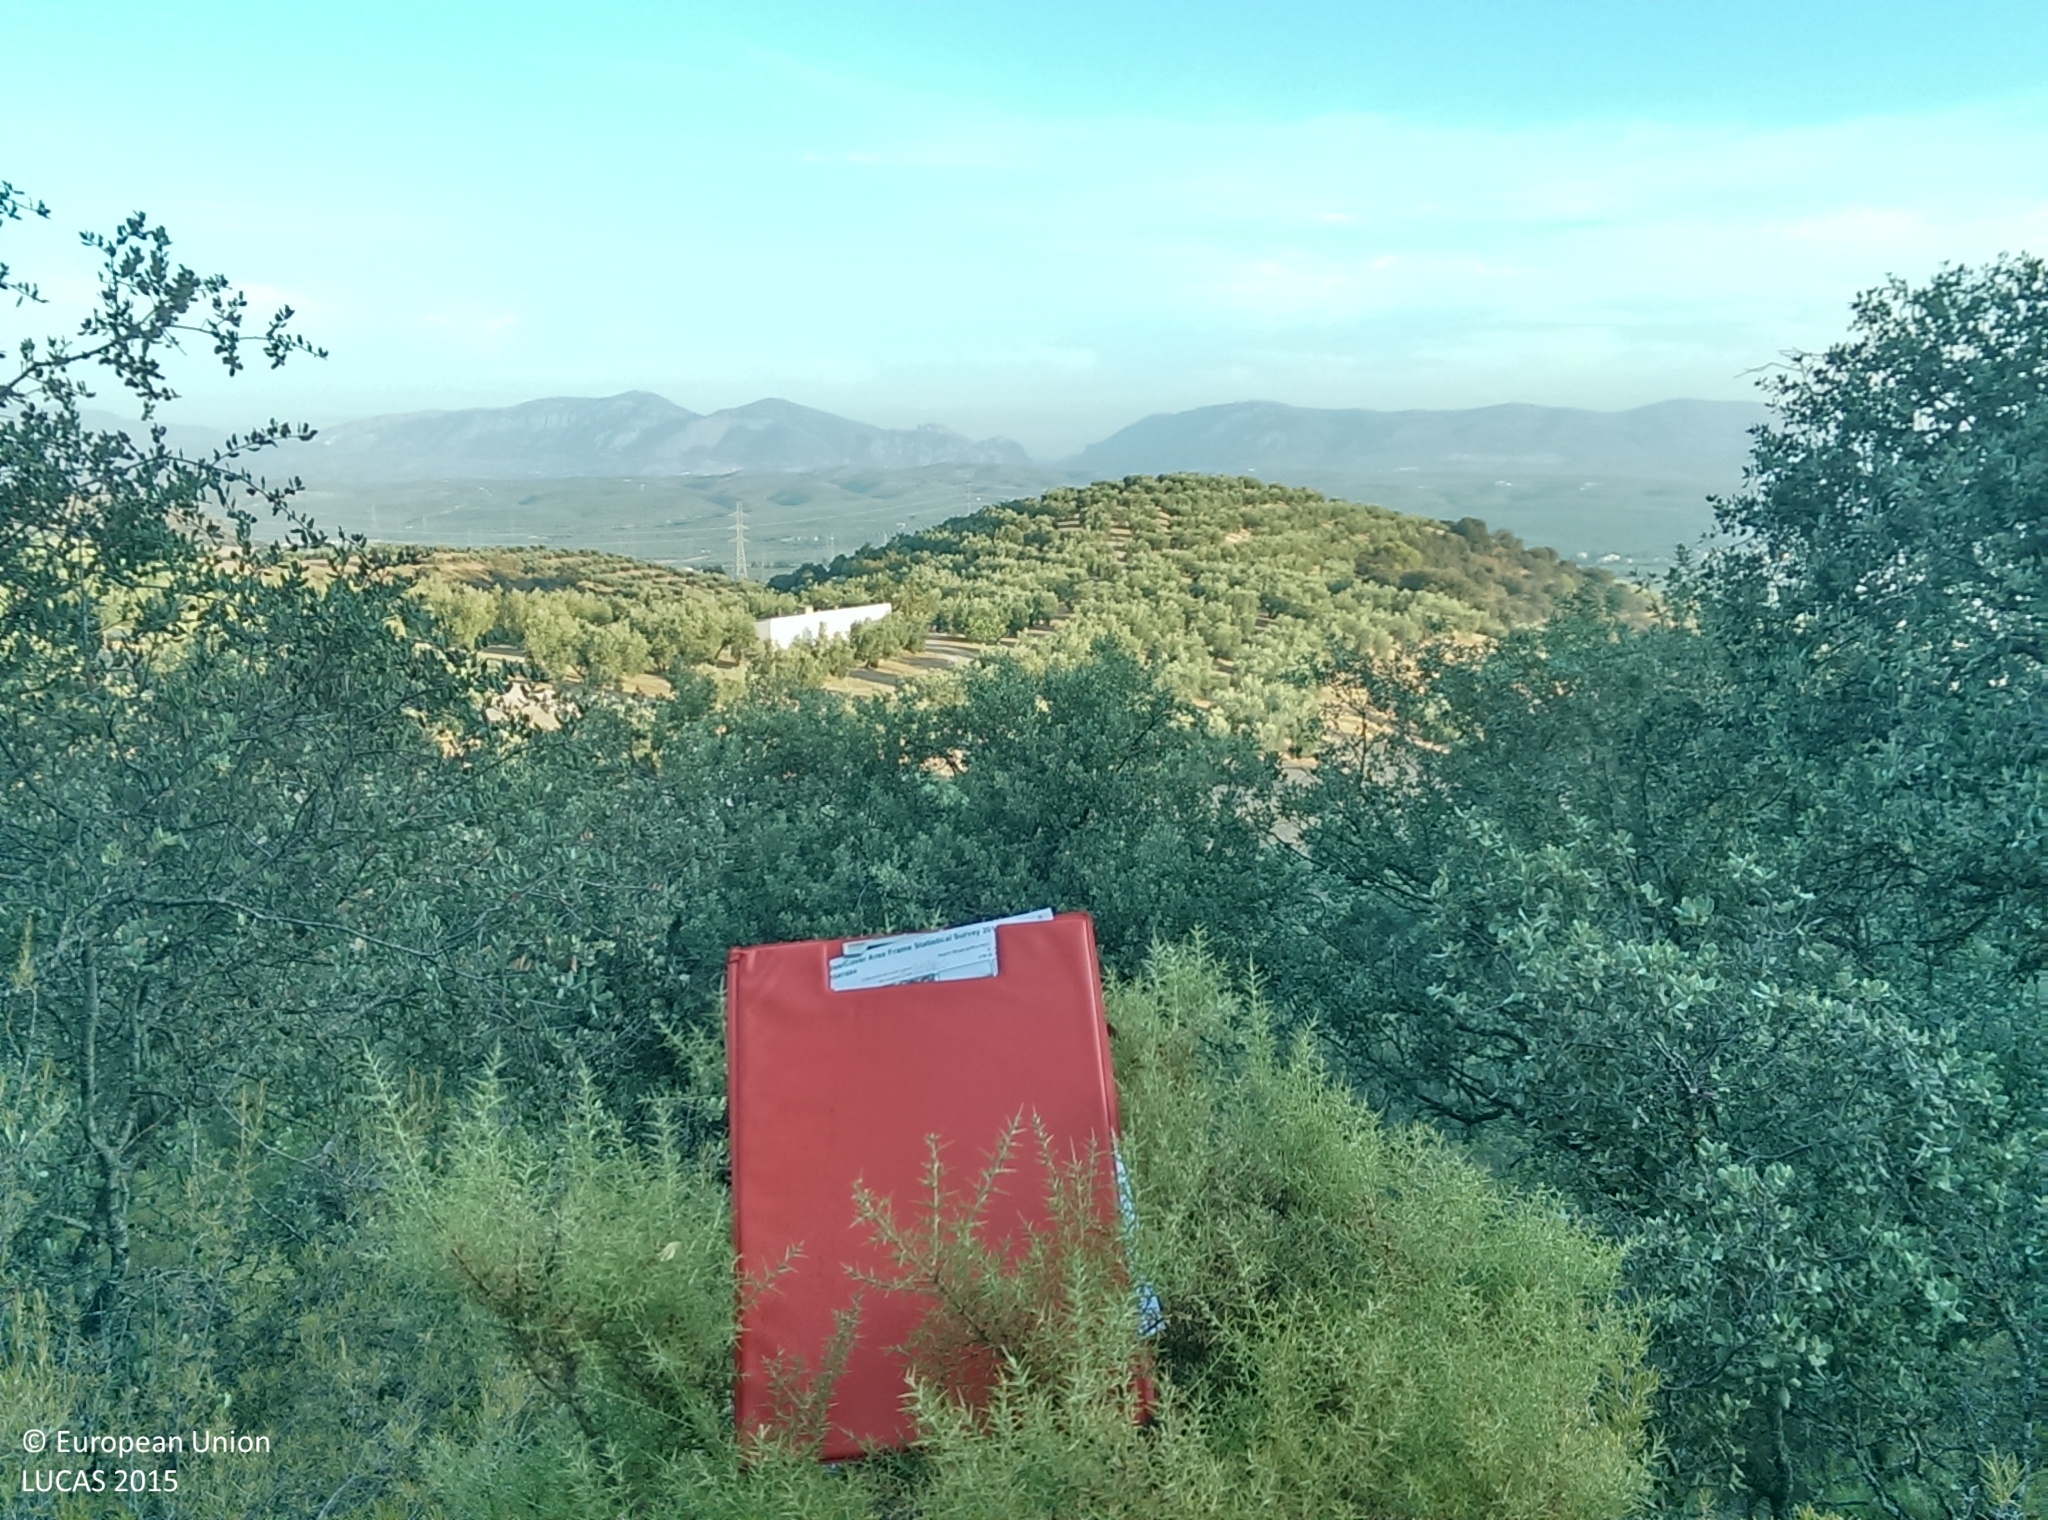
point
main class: Woodland
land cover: Broadleaved woodland
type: broadleaved evergreen forest
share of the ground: 50 - 75 %
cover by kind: broadleaved forest trees 60 %, shrubs 30 %, unconsolidated bare surface 10 %
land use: Semi-natural and natural areas not in use
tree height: < 5 m
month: August
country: ES
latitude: 37.2484
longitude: -3.6889
